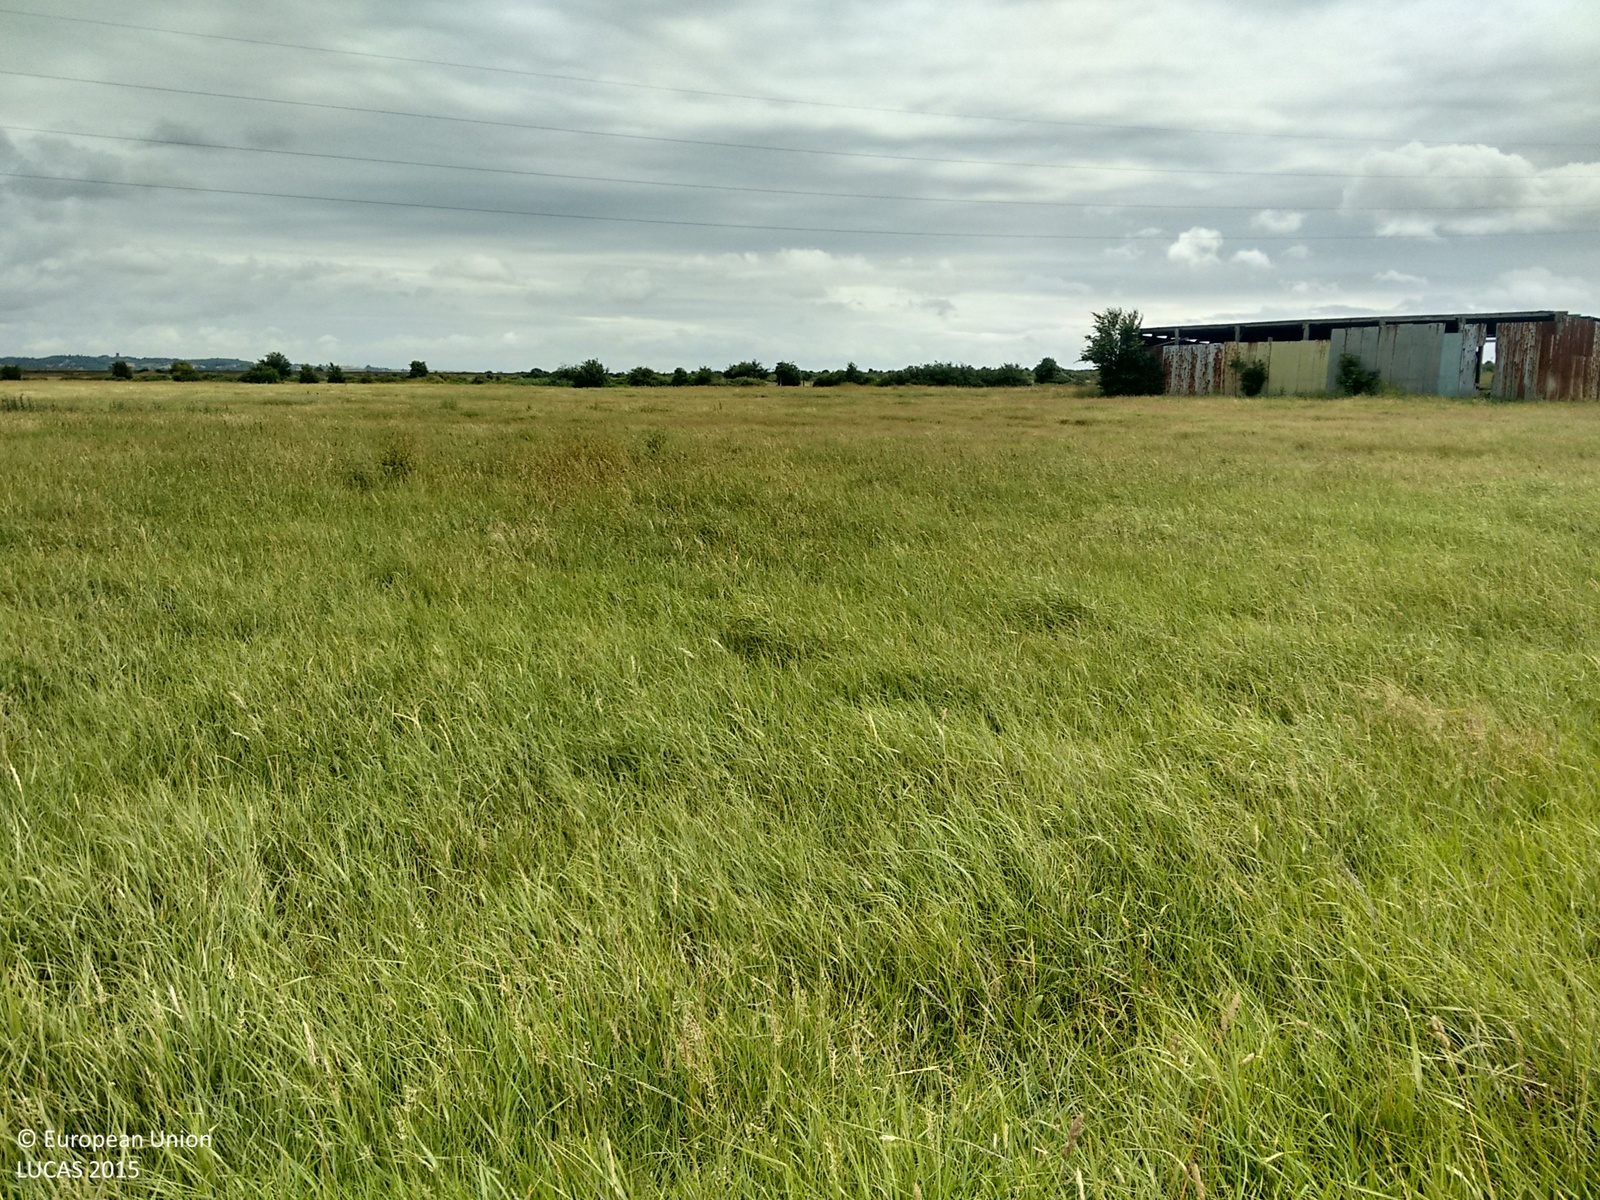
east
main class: Grassland
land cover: Grassland without tree/shrub cover
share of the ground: > 75 %
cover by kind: herbaceous plants 100 %
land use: Agriculture (excluding fallow land and kitchen gardens)
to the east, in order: Grassland without tree/shrub cover; Electric lines; Grassland without tree/shrub cover; Fences; Ditches and canals; Grassland with sparse tree/shrub cover; Tracks; Grassland without tree/shrub cover; Ditches and canals; Fences; Grassland without tree/shrub cover
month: July
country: GB
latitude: 51.5252
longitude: 0.5025
